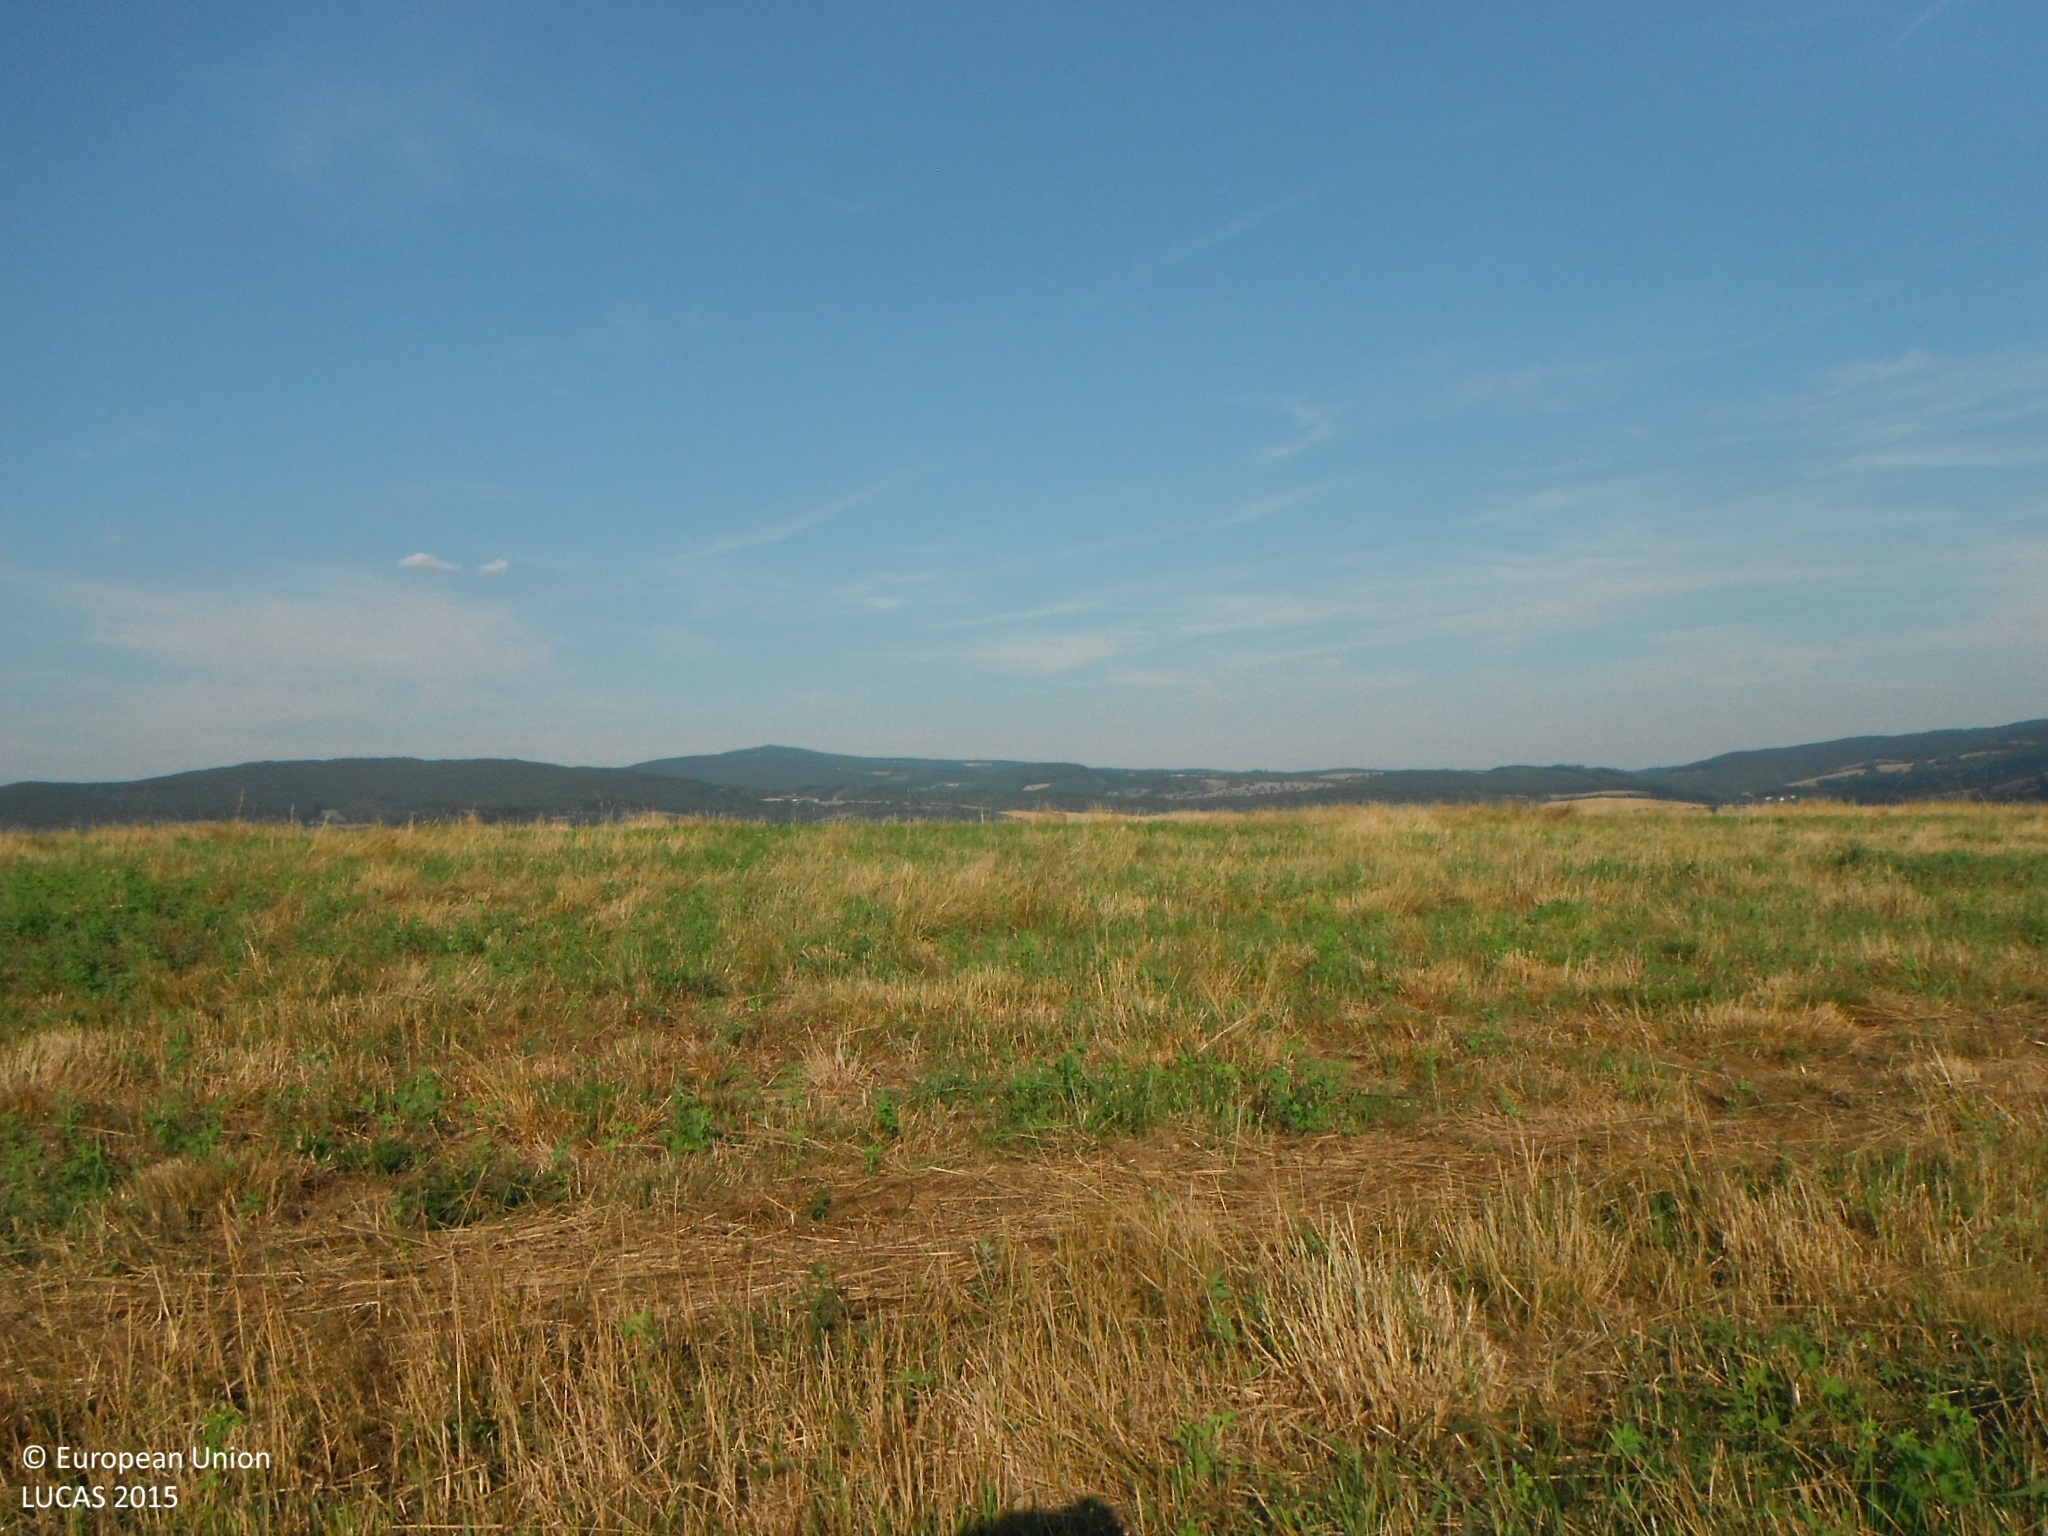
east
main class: Cropland
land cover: Other leguminous and mixtures for fodder
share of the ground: > 75 %
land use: Agriculture (excluding fallow land and kitchen gardens)
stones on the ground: < 10 %
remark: Harvested field
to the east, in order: Other leguminous and mixtures for fodder
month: August
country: SK
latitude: 48.4246
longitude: 19.1160
